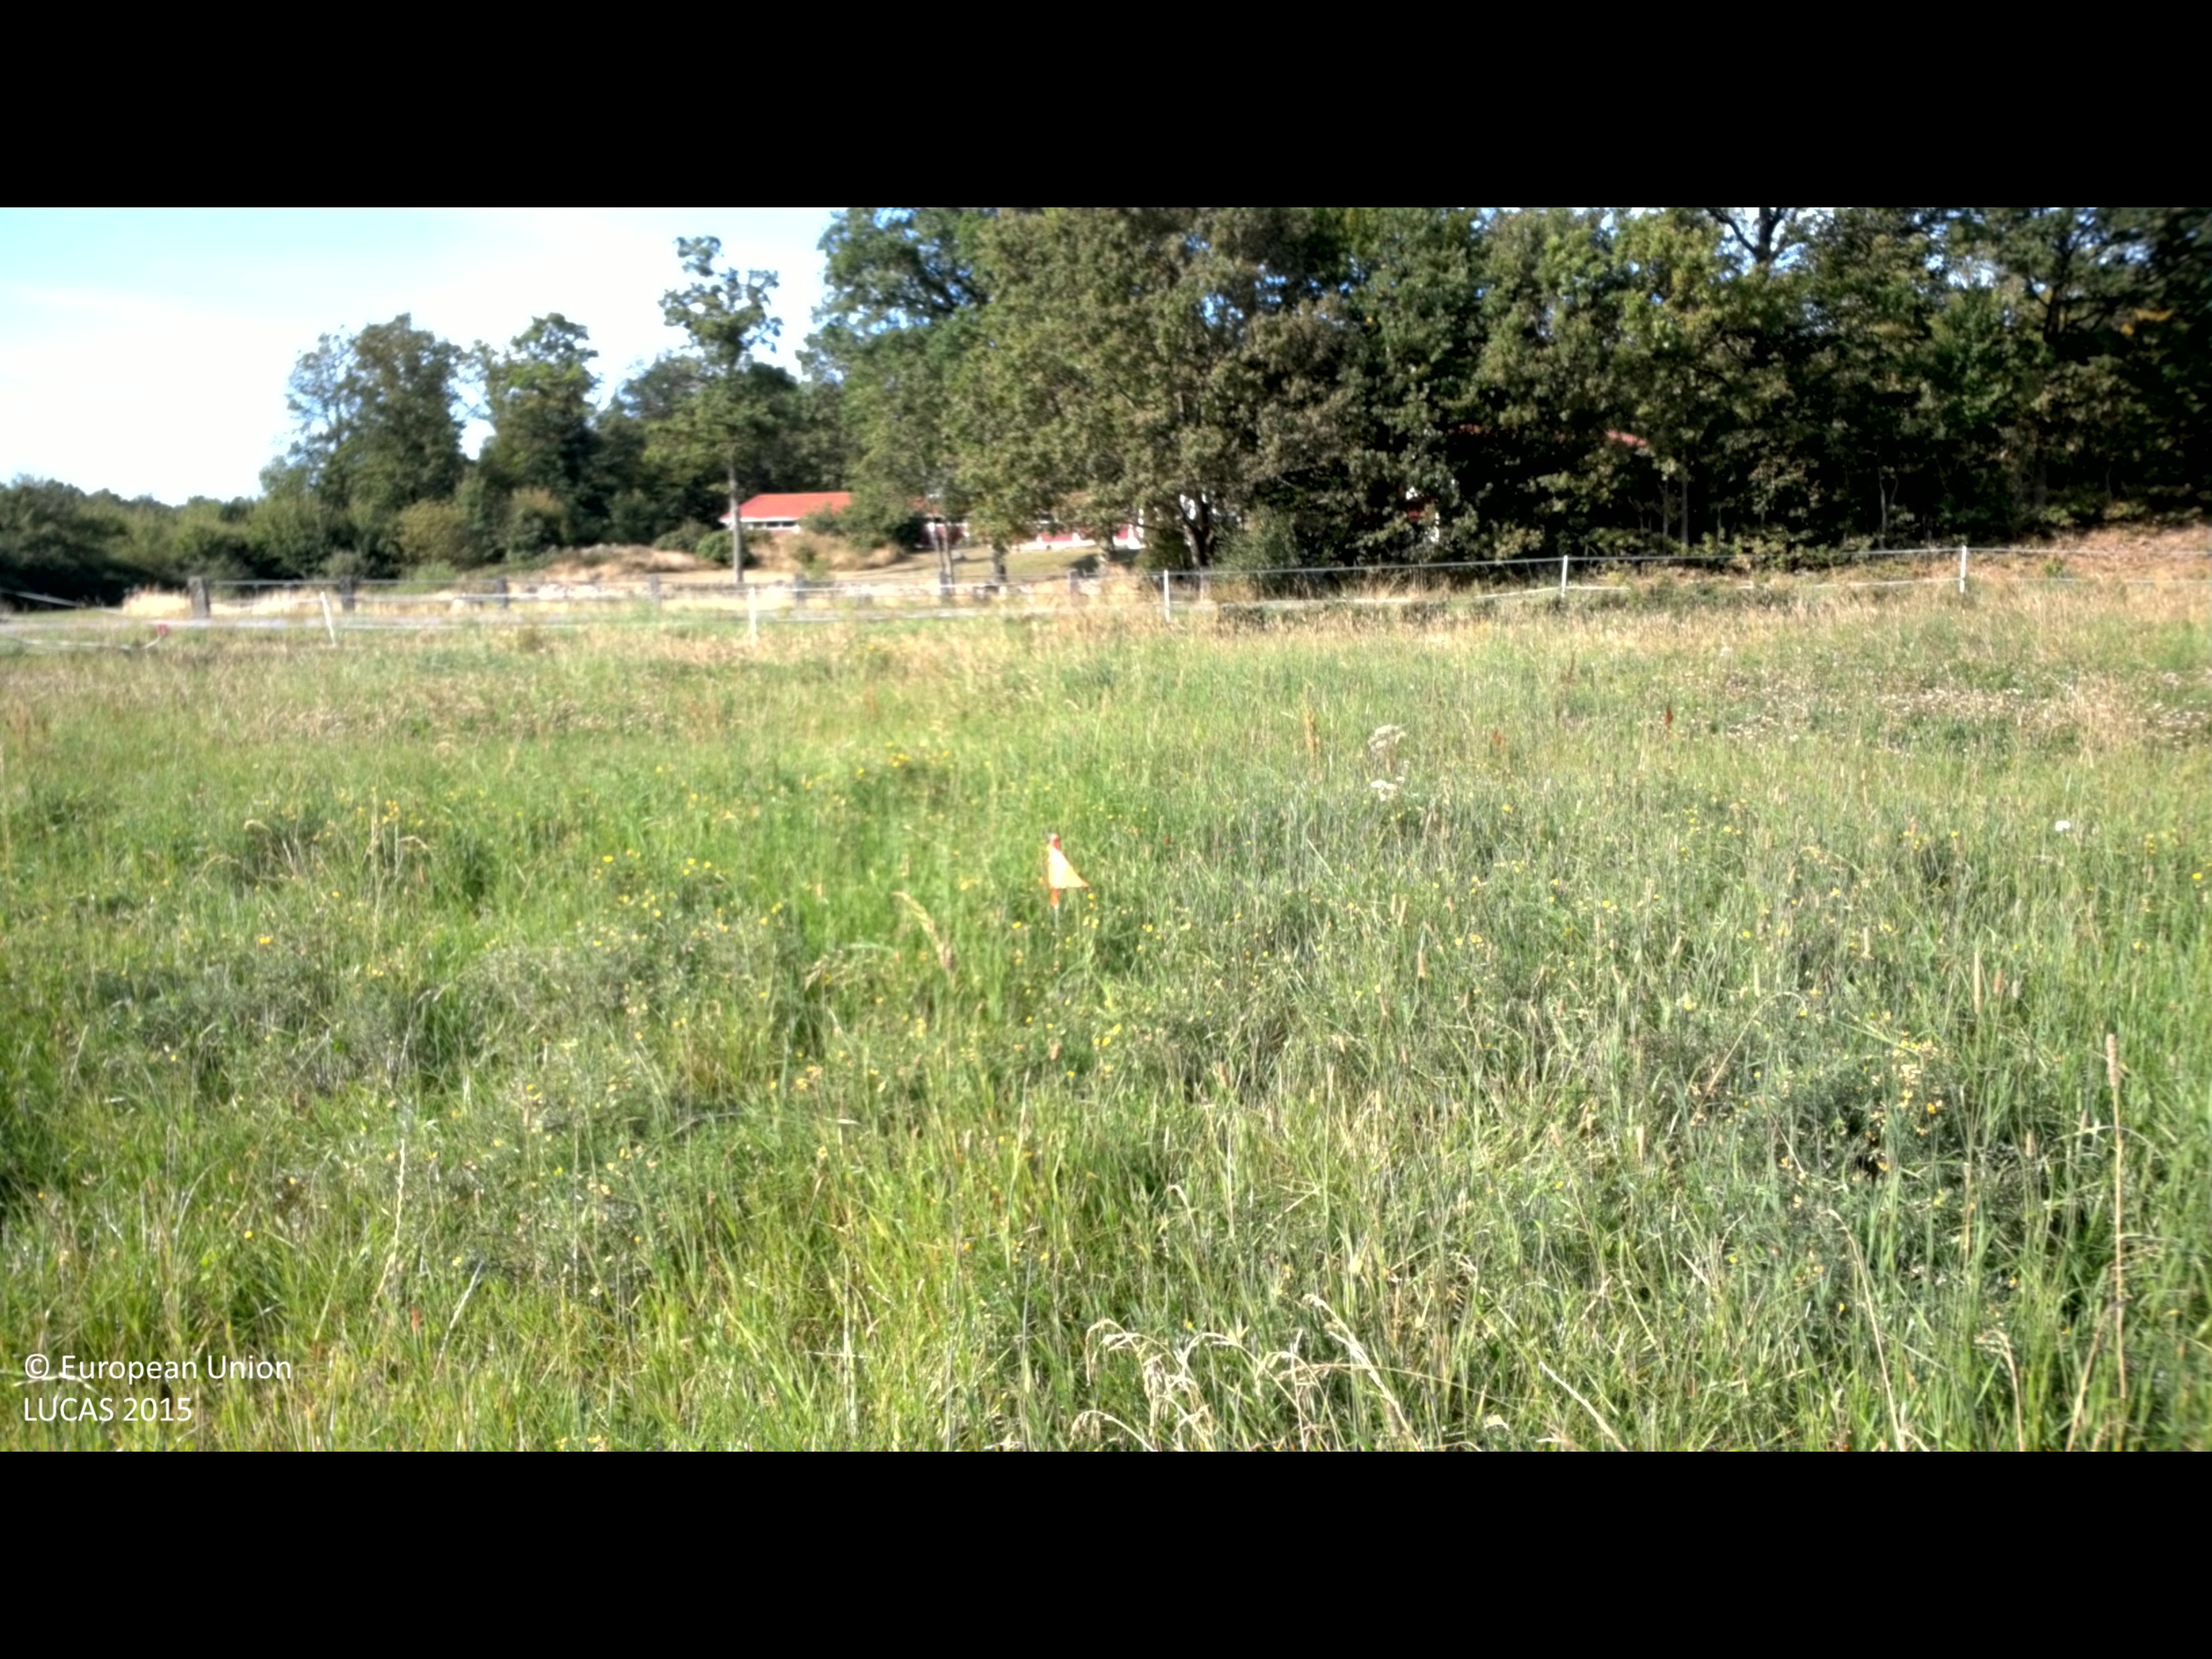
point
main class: Grassland
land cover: Grassland without tree/shrub cover
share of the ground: > 75 %
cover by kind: herbaceous plants 100 %
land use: Agriculture (excluding fallow land and kitchen gardens)
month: August
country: SE
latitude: 56.1923
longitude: 14.6877
